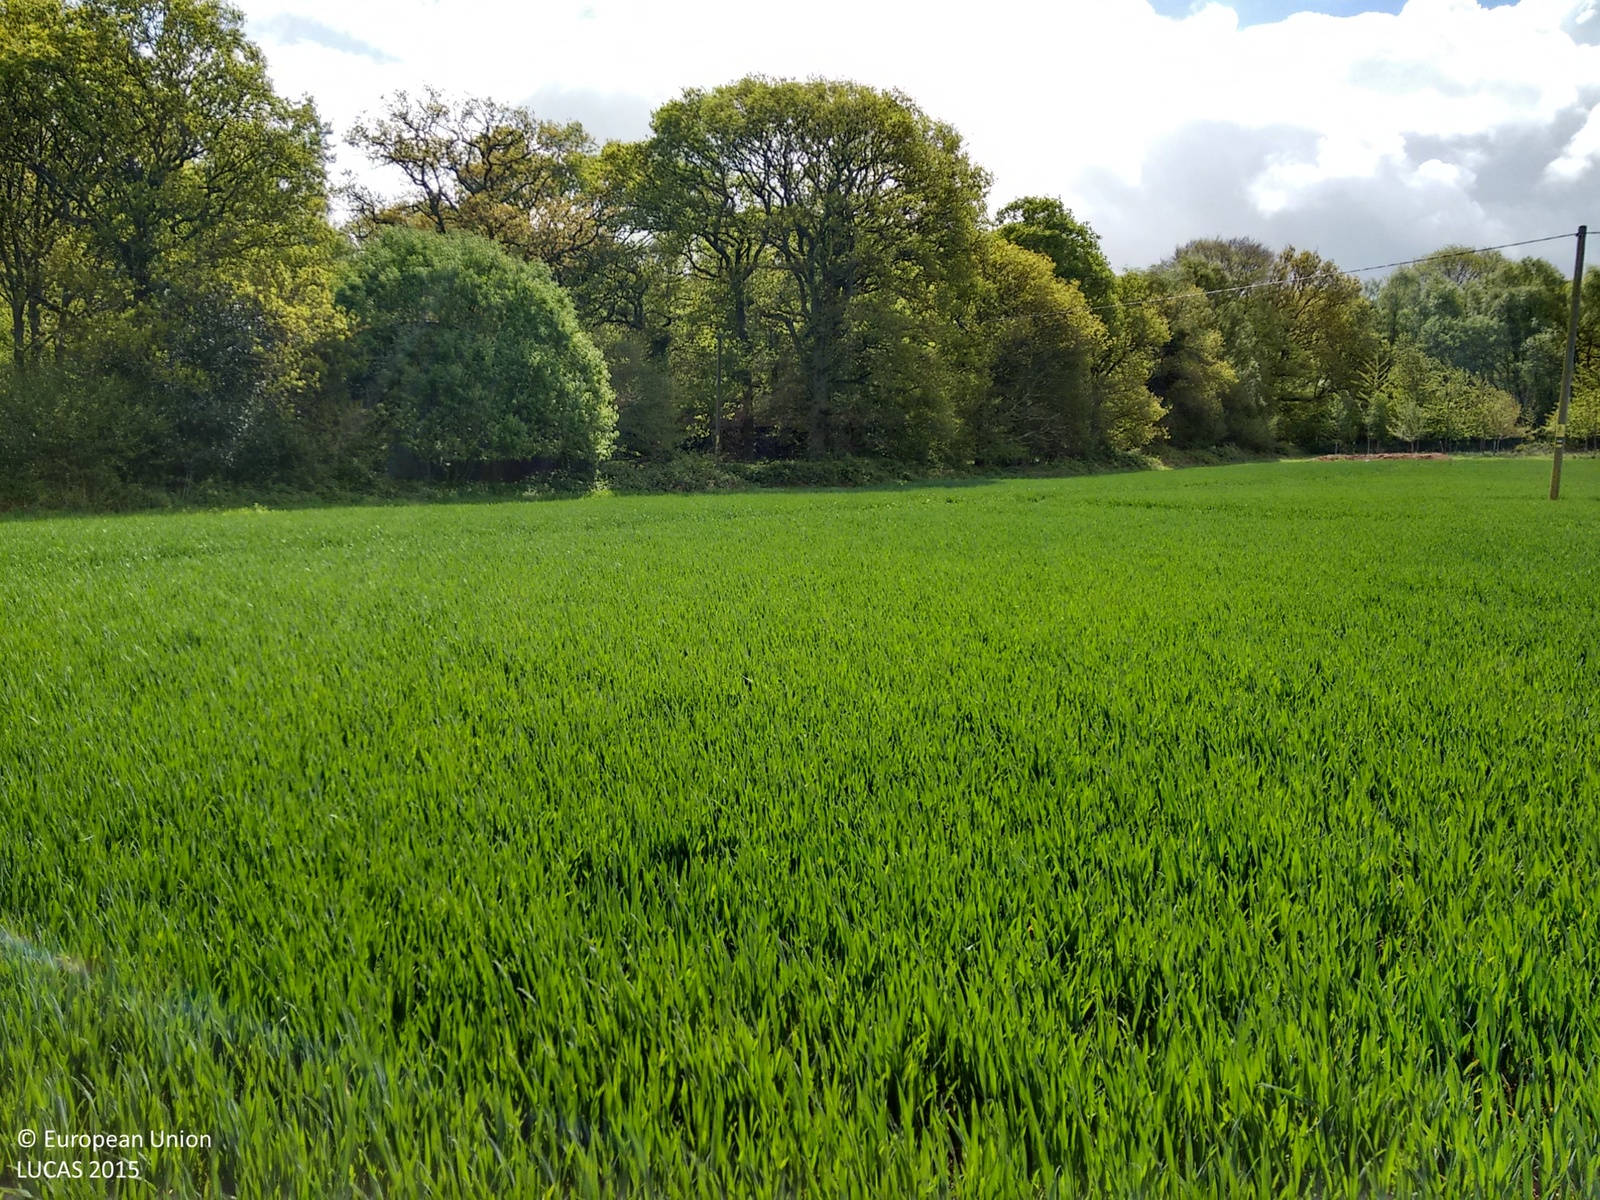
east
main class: Cropland
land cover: Common wheat
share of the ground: > 75 %
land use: Agriculture (excluding fallow land and kitchen gardens)
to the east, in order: Common wheat; Grass margins; Single bushes/trees; Artificial constructions in urban areas; Broadleaved woodland; Paved roads, cycling and walking lanes; Grass margins; Managed hedges; Lines of trees; Spontaneously vegetated surfaces; Barley
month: May
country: GB
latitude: 51.0789
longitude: -1.4264
